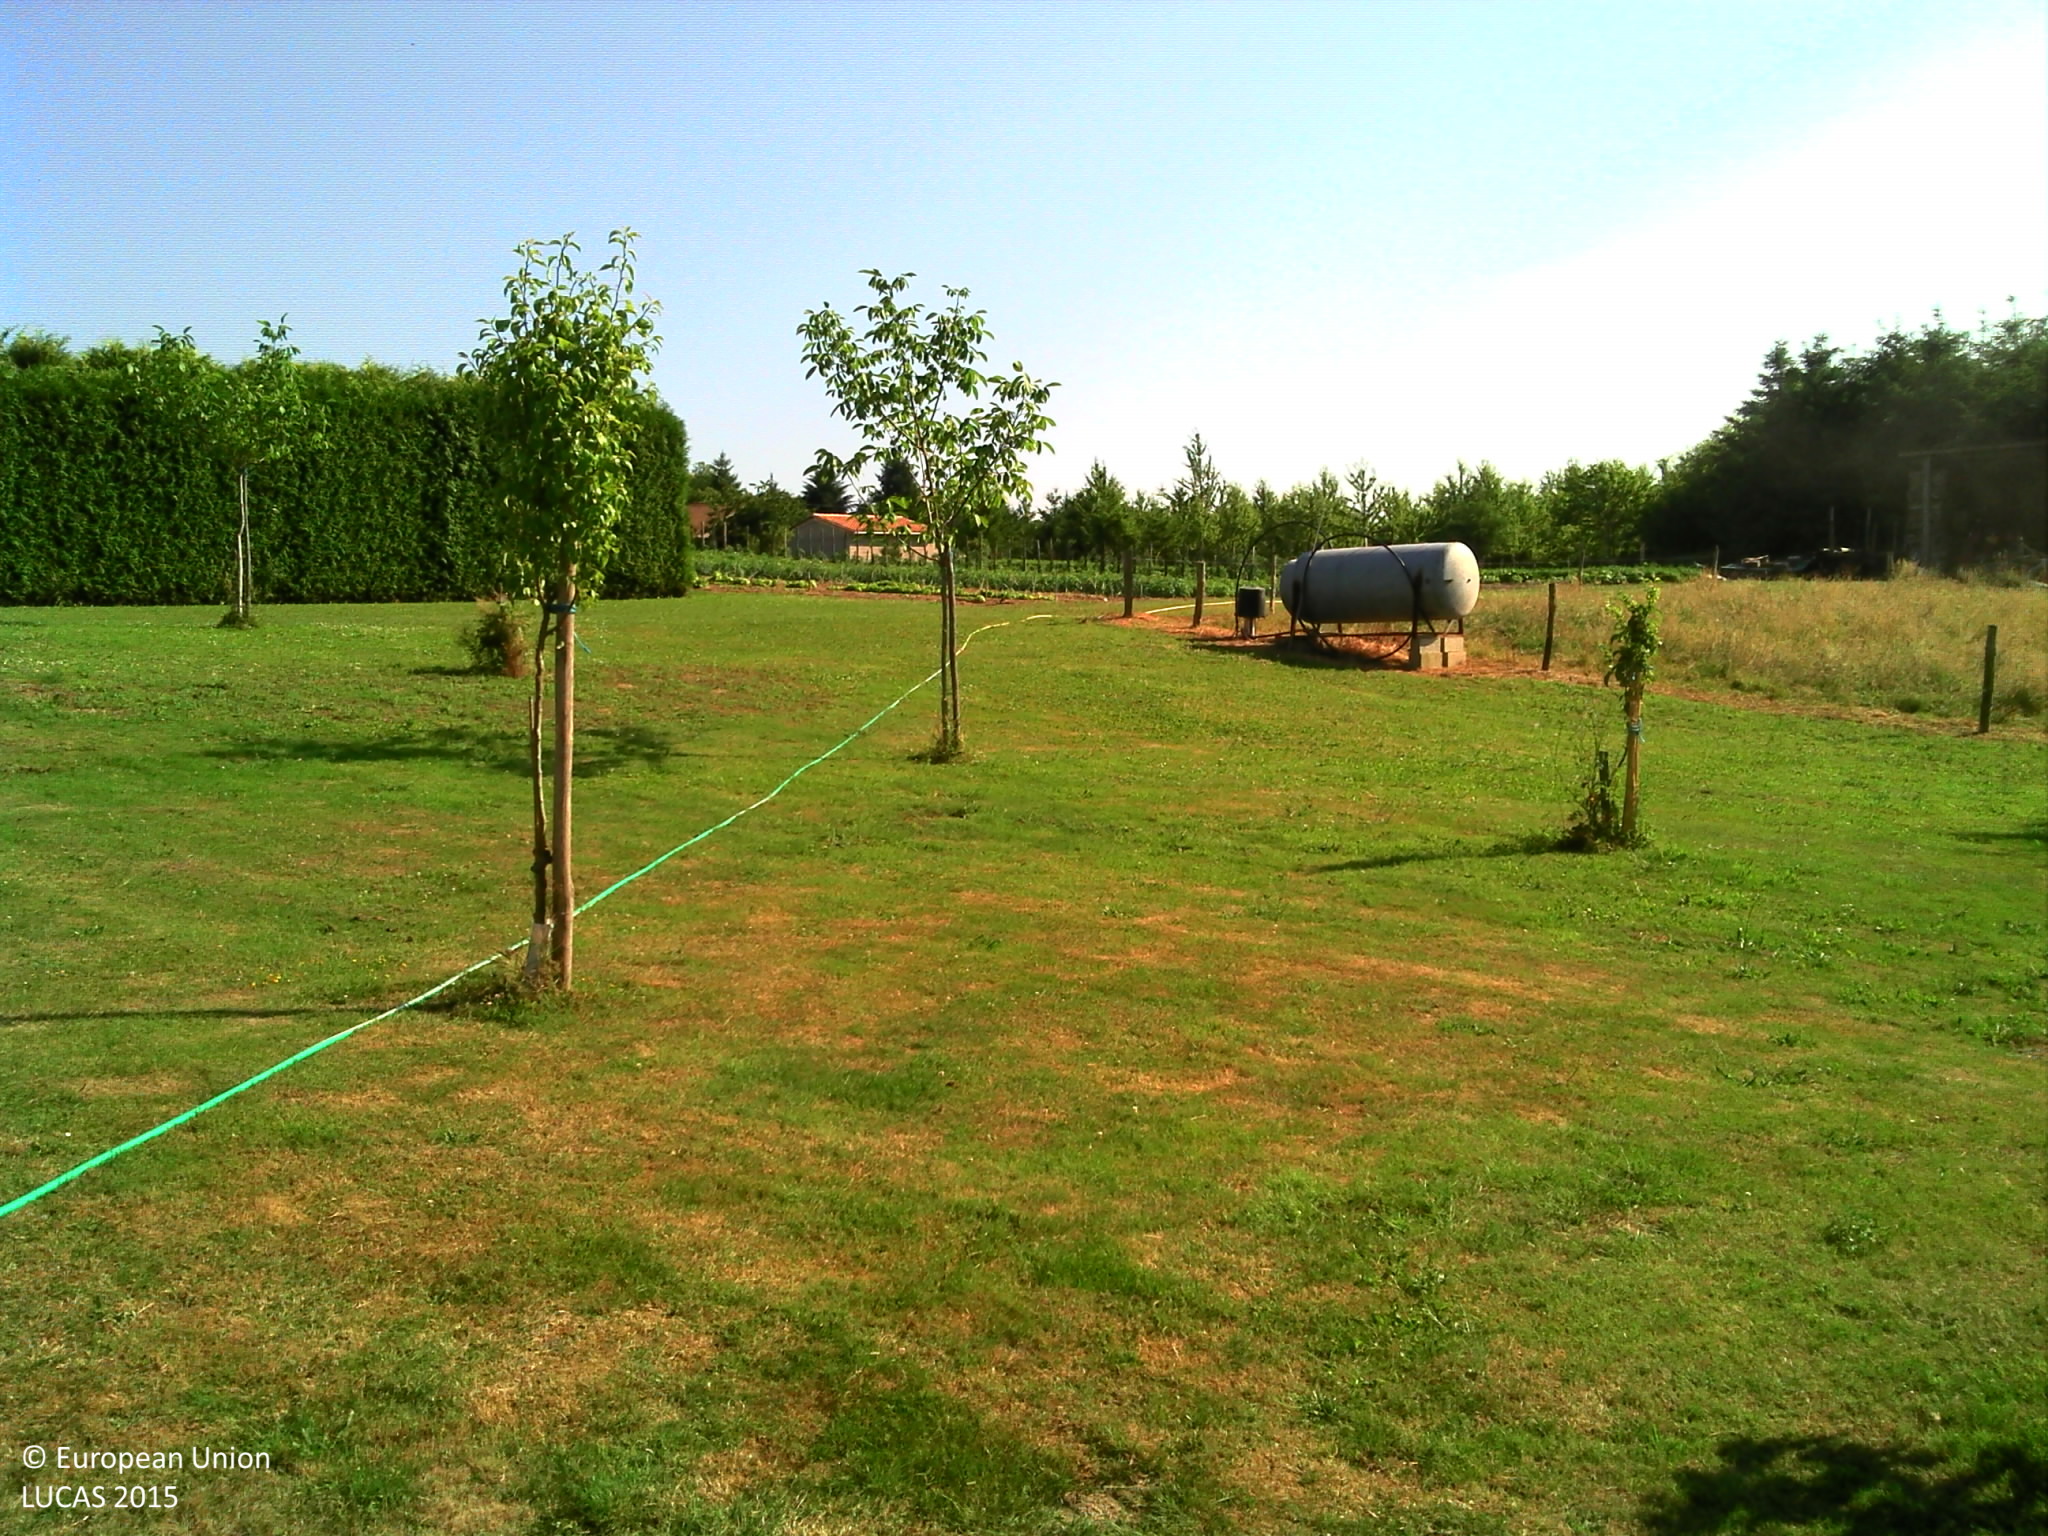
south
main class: Grassland
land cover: Grassland with sparse tree/shrub cover
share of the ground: > 75 %
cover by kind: herbaceous plants 95 %, broadleaved forest trees 5 %
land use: Residential
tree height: > 5 m
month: June
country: FR
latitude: 45.7363
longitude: 0.5922
